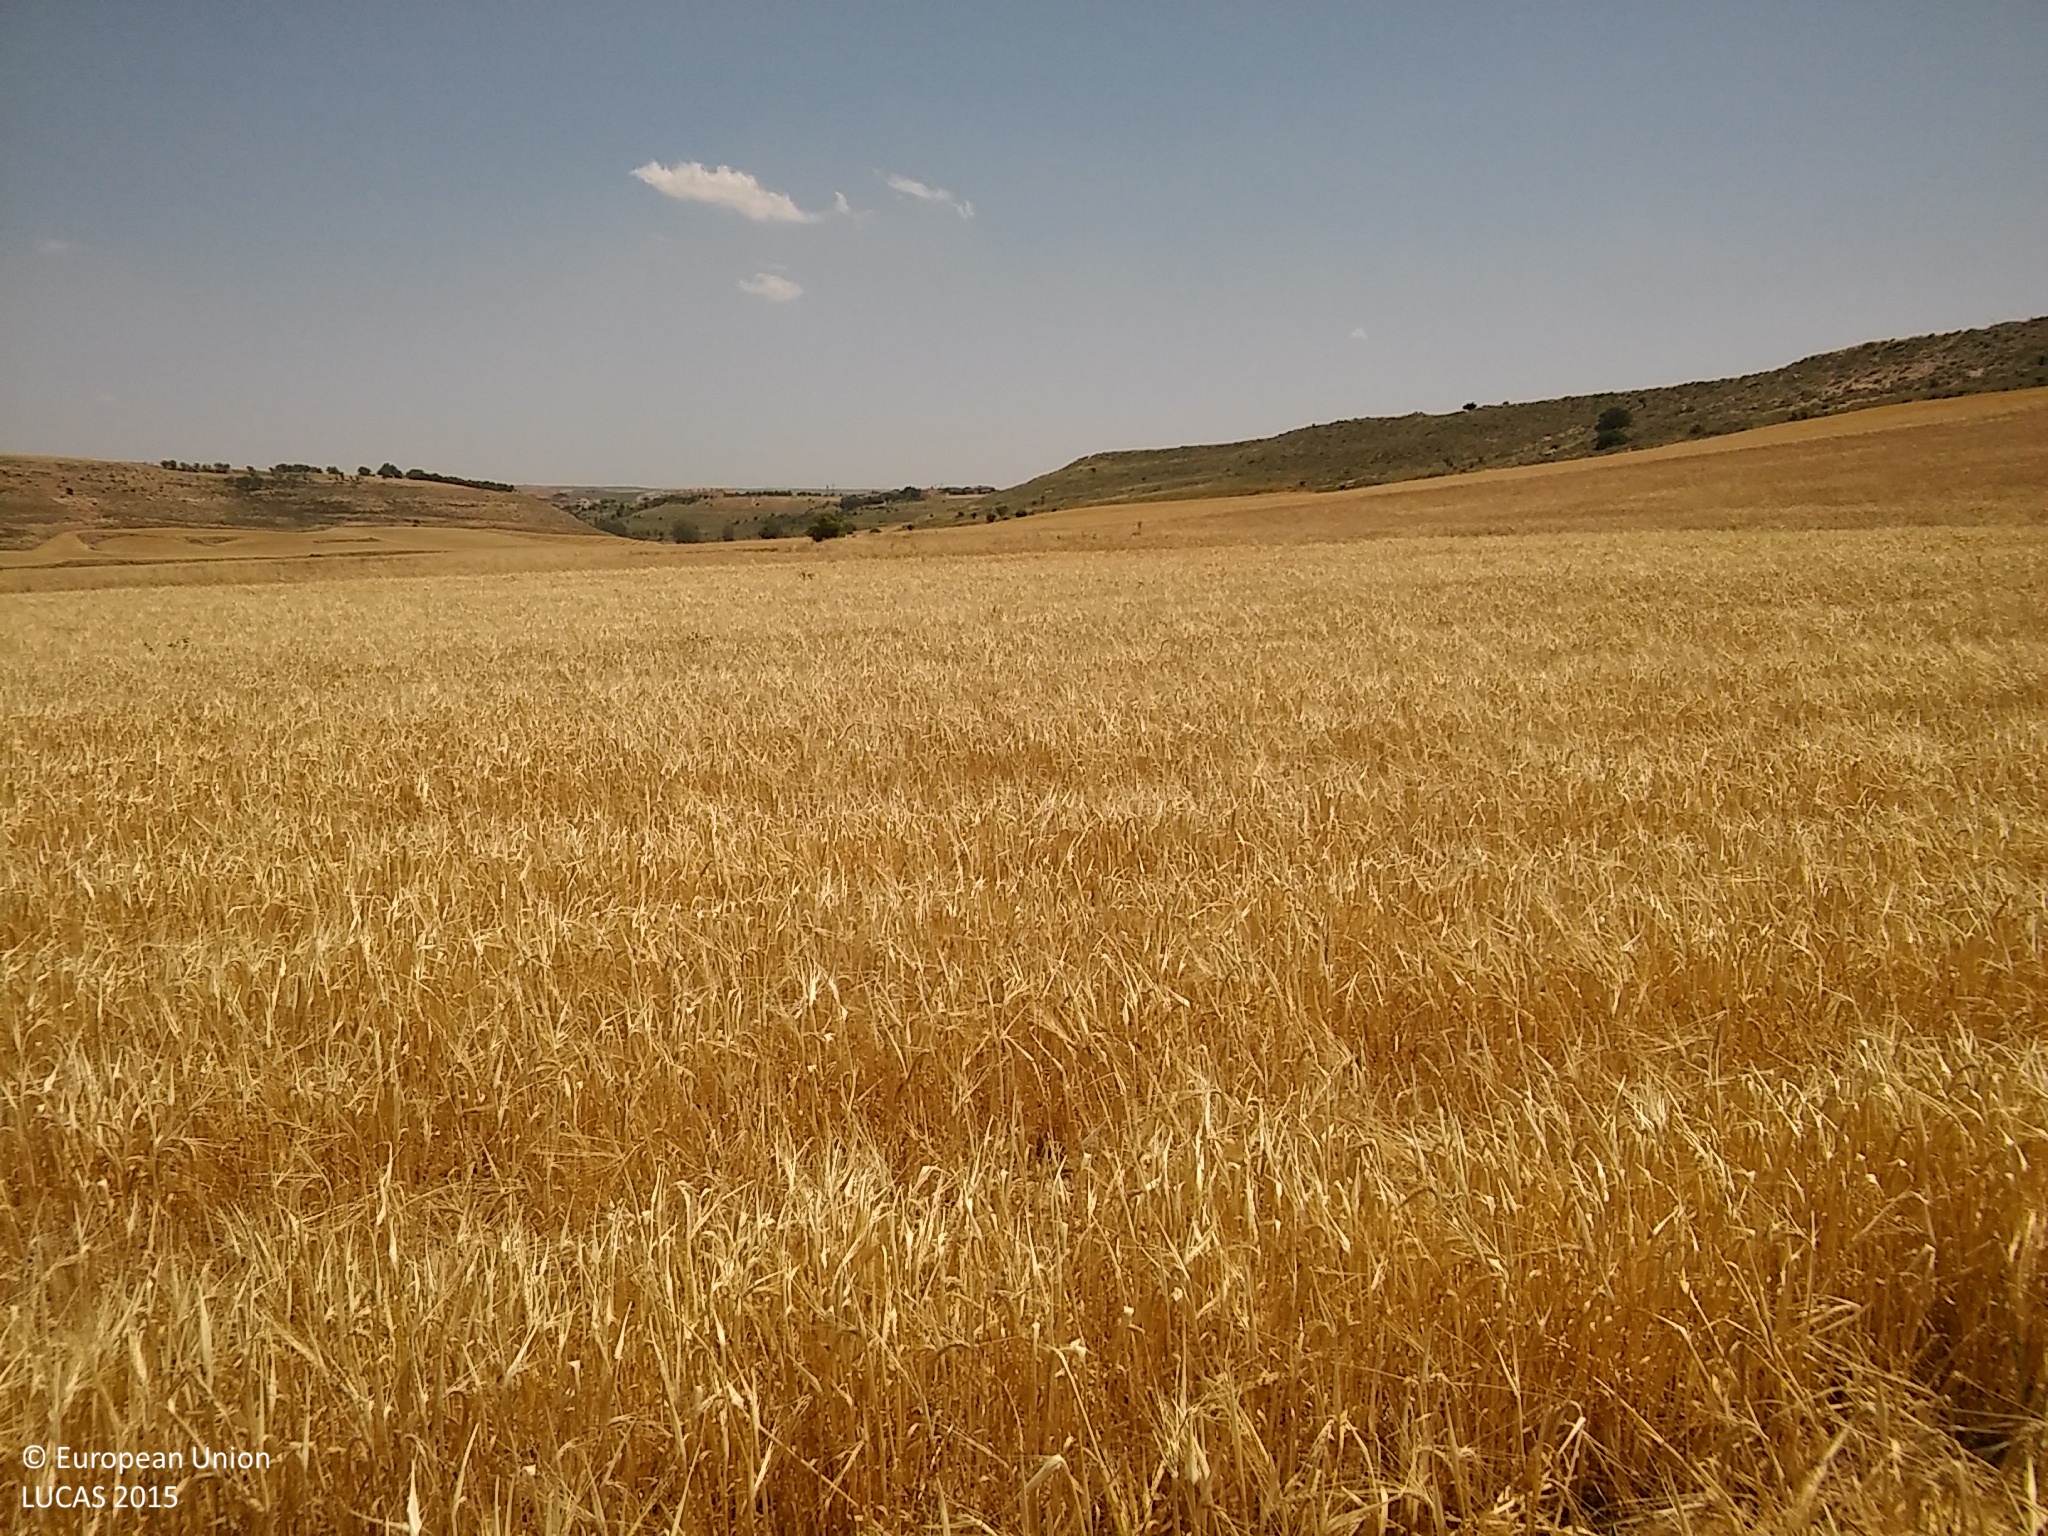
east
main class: Cropland
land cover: Barley
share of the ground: > 75 %
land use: Agriculture (excluding fallow land and kitchen gardens)
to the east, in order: Barley; Spontaneously vegetated surfaces; Grass margins; Spontaneously vegetated surfaces; Common wheat; Mixed cereals for fodder; Barley
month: July
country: ES
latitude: 41.4833
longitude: -3.5459
